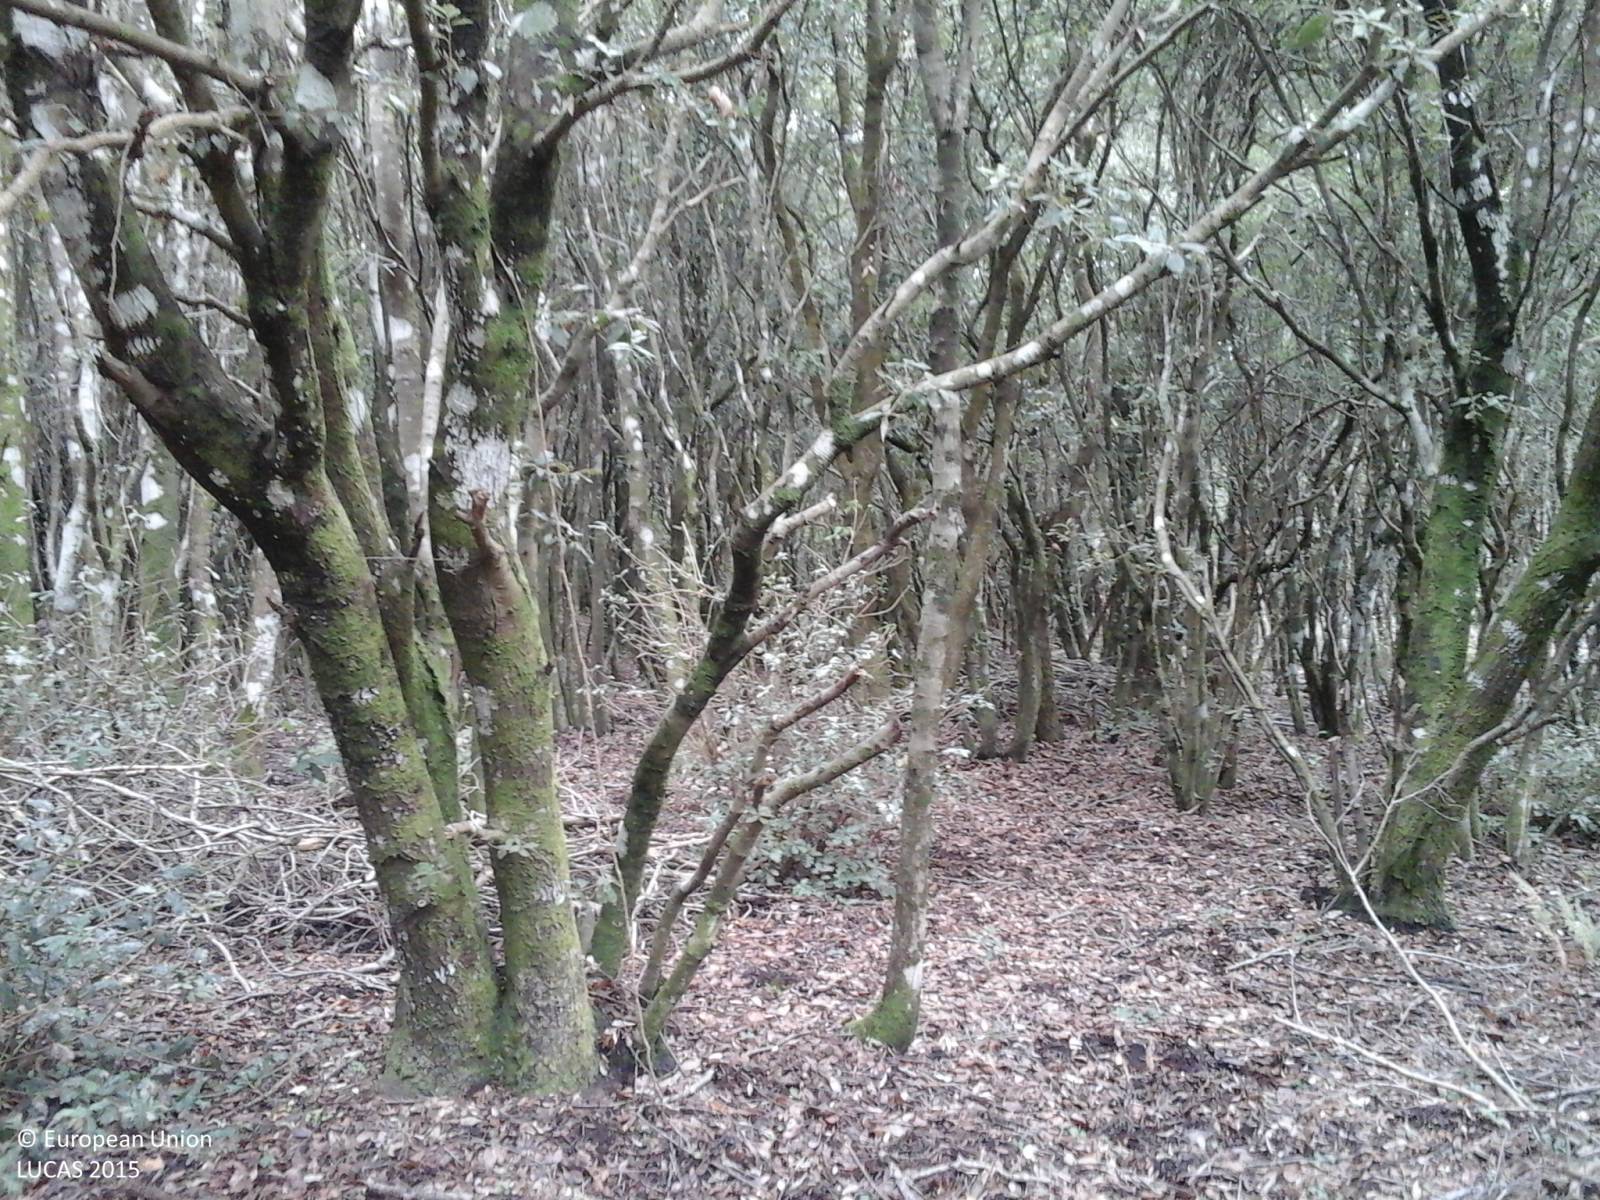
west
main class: Woodland
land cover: Broadleaved woodland
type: broadleaved evergreen forest
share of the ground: > 75 %
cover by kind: broadleaved forest trees 100 %
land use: Forestry
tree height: > 5 m
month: September
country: IT
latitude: 40.2403
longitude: 8.6787
